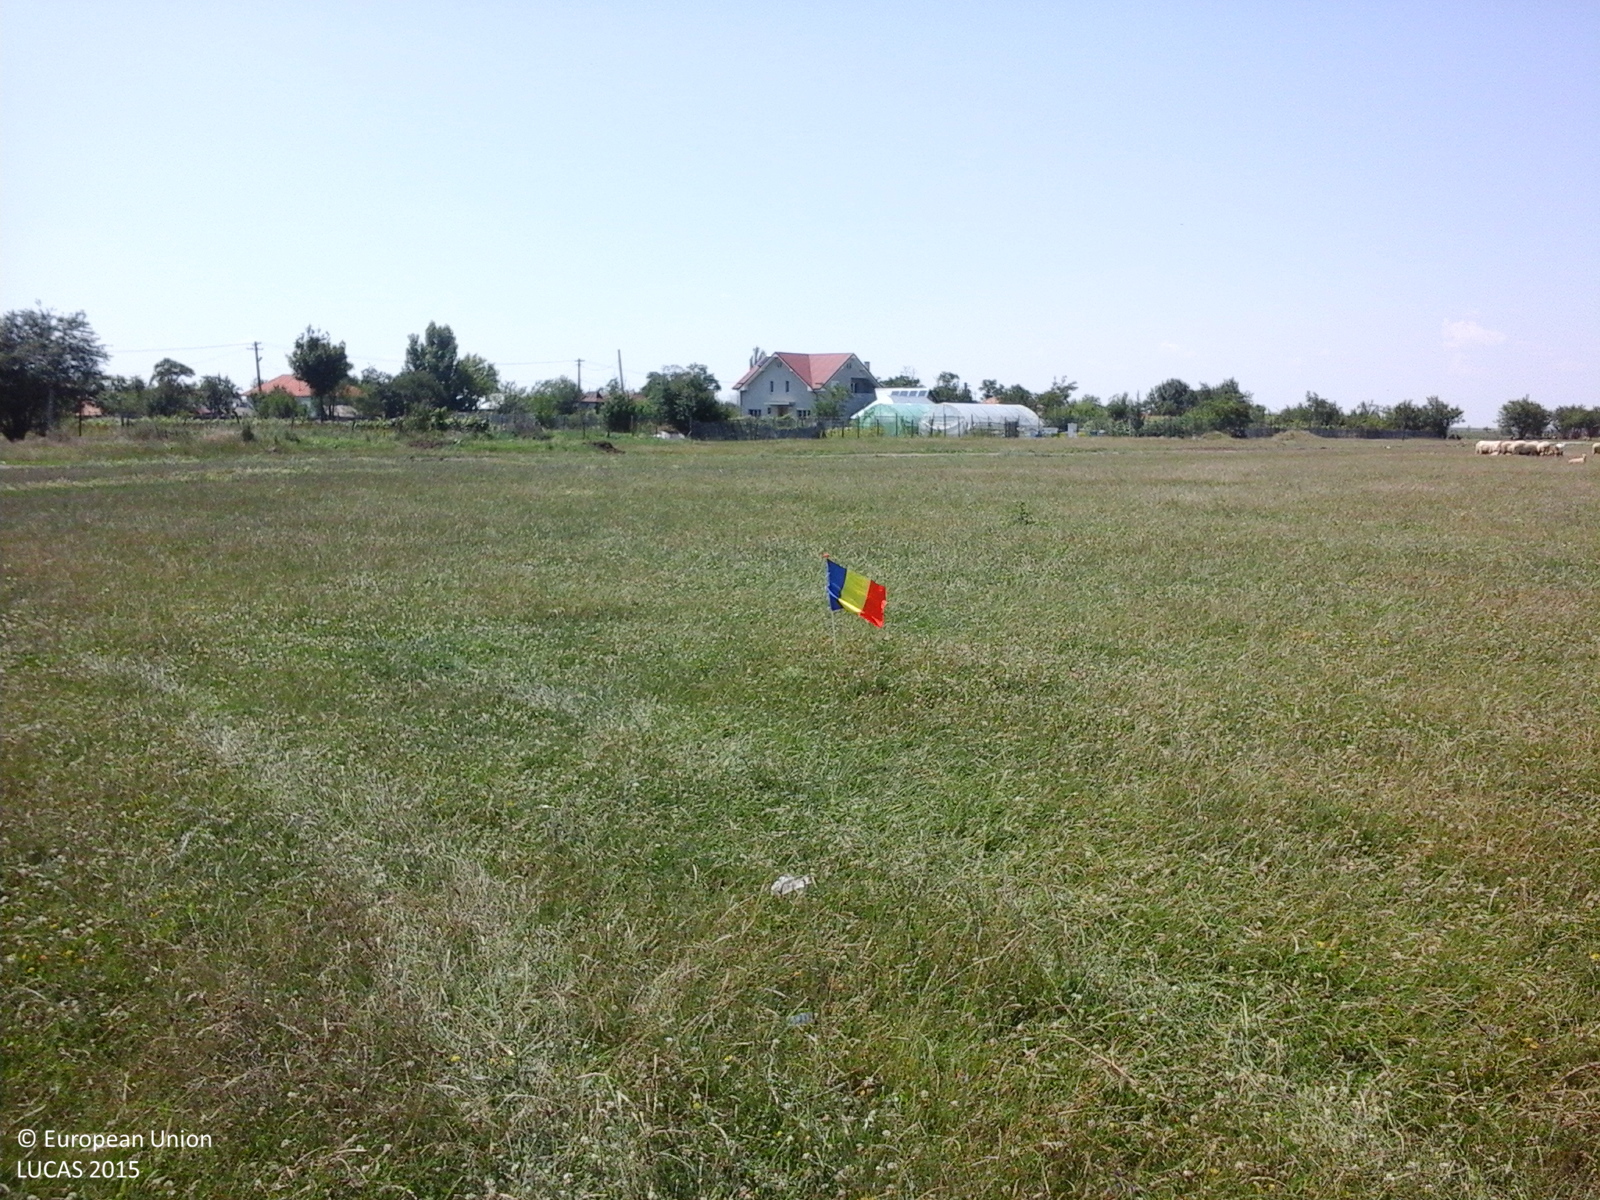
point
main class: Grassland
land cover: Grassland without tree/shrub cover
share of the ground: > 75 %
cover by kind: herbaceous plants 100 %
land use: Agriculture (excluding fallow land and kitchen gardens)
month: July
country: RO
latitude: 44.4657
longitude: 24.4622
